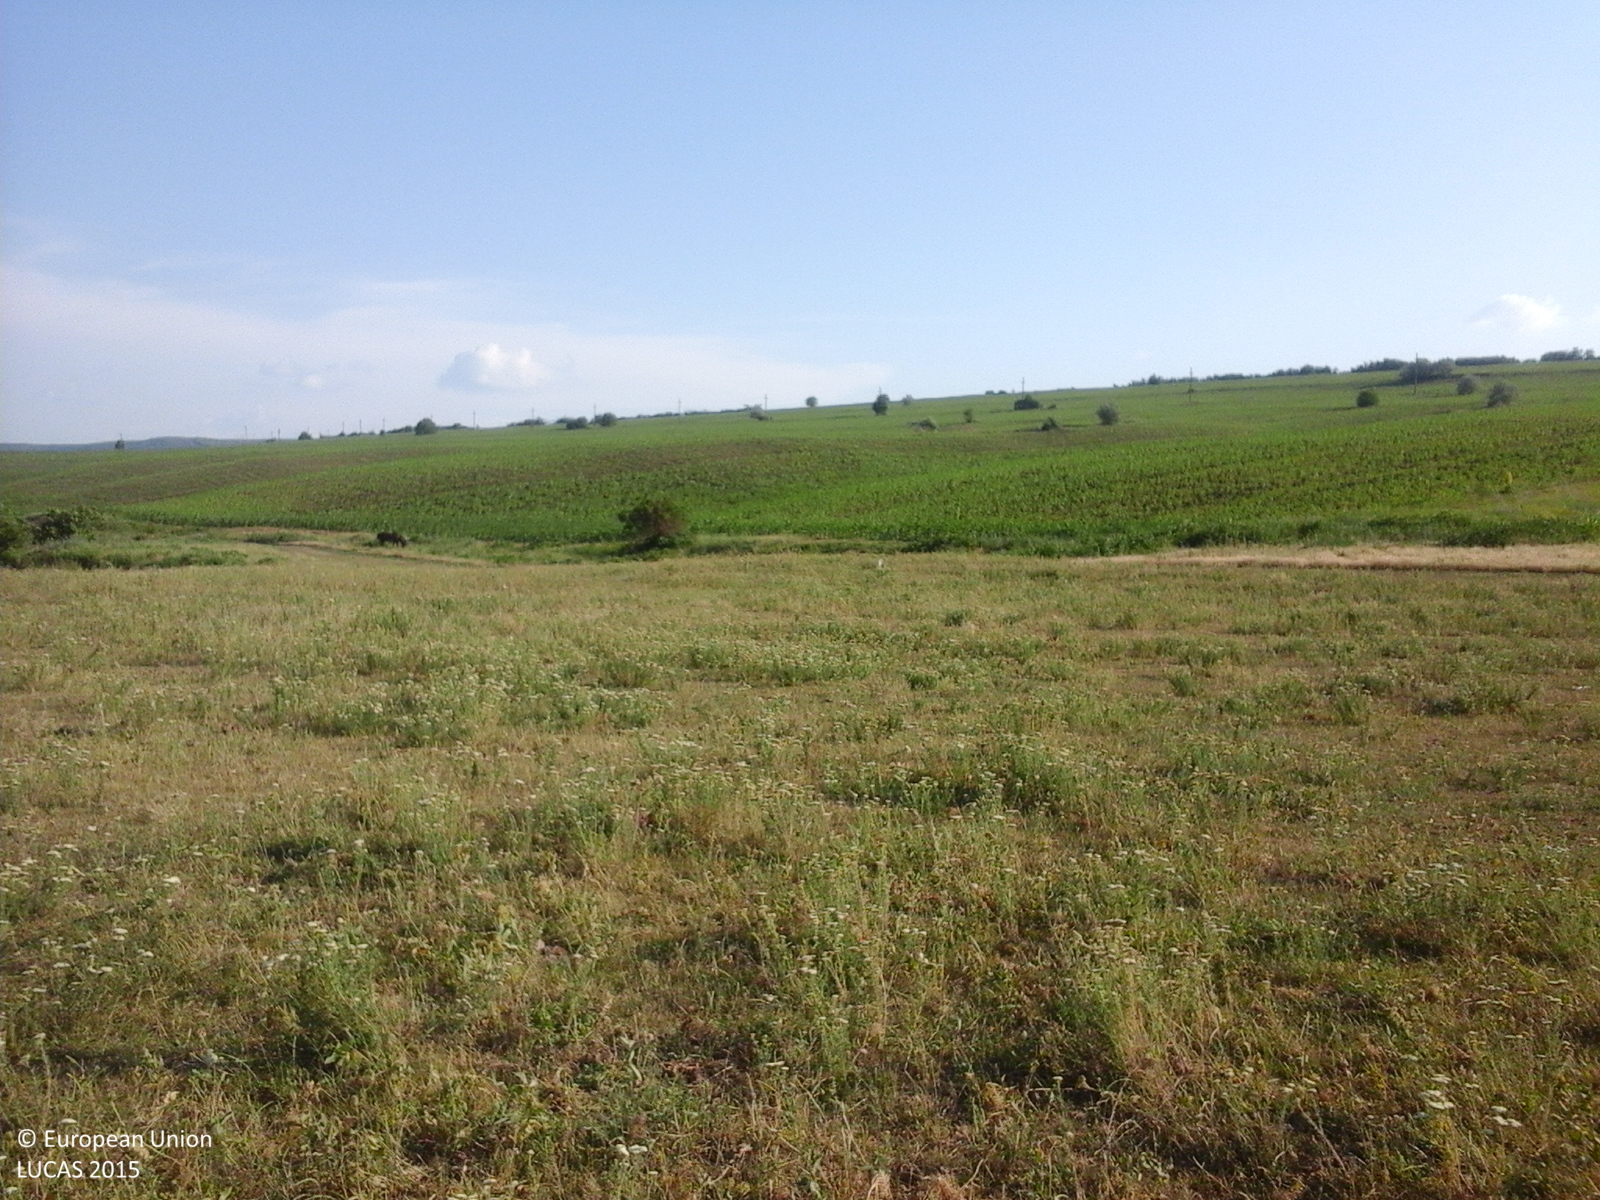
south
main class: Grassland
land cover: Grassland without tree/shrub cover
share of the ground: > 75 %
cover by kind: herbaceous plants 95 %, shrubs 5 %
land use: Agriculture (excluding fallow land and kitchen gardens)
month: June
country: RO
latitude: 46.7792
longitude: 27.8986
